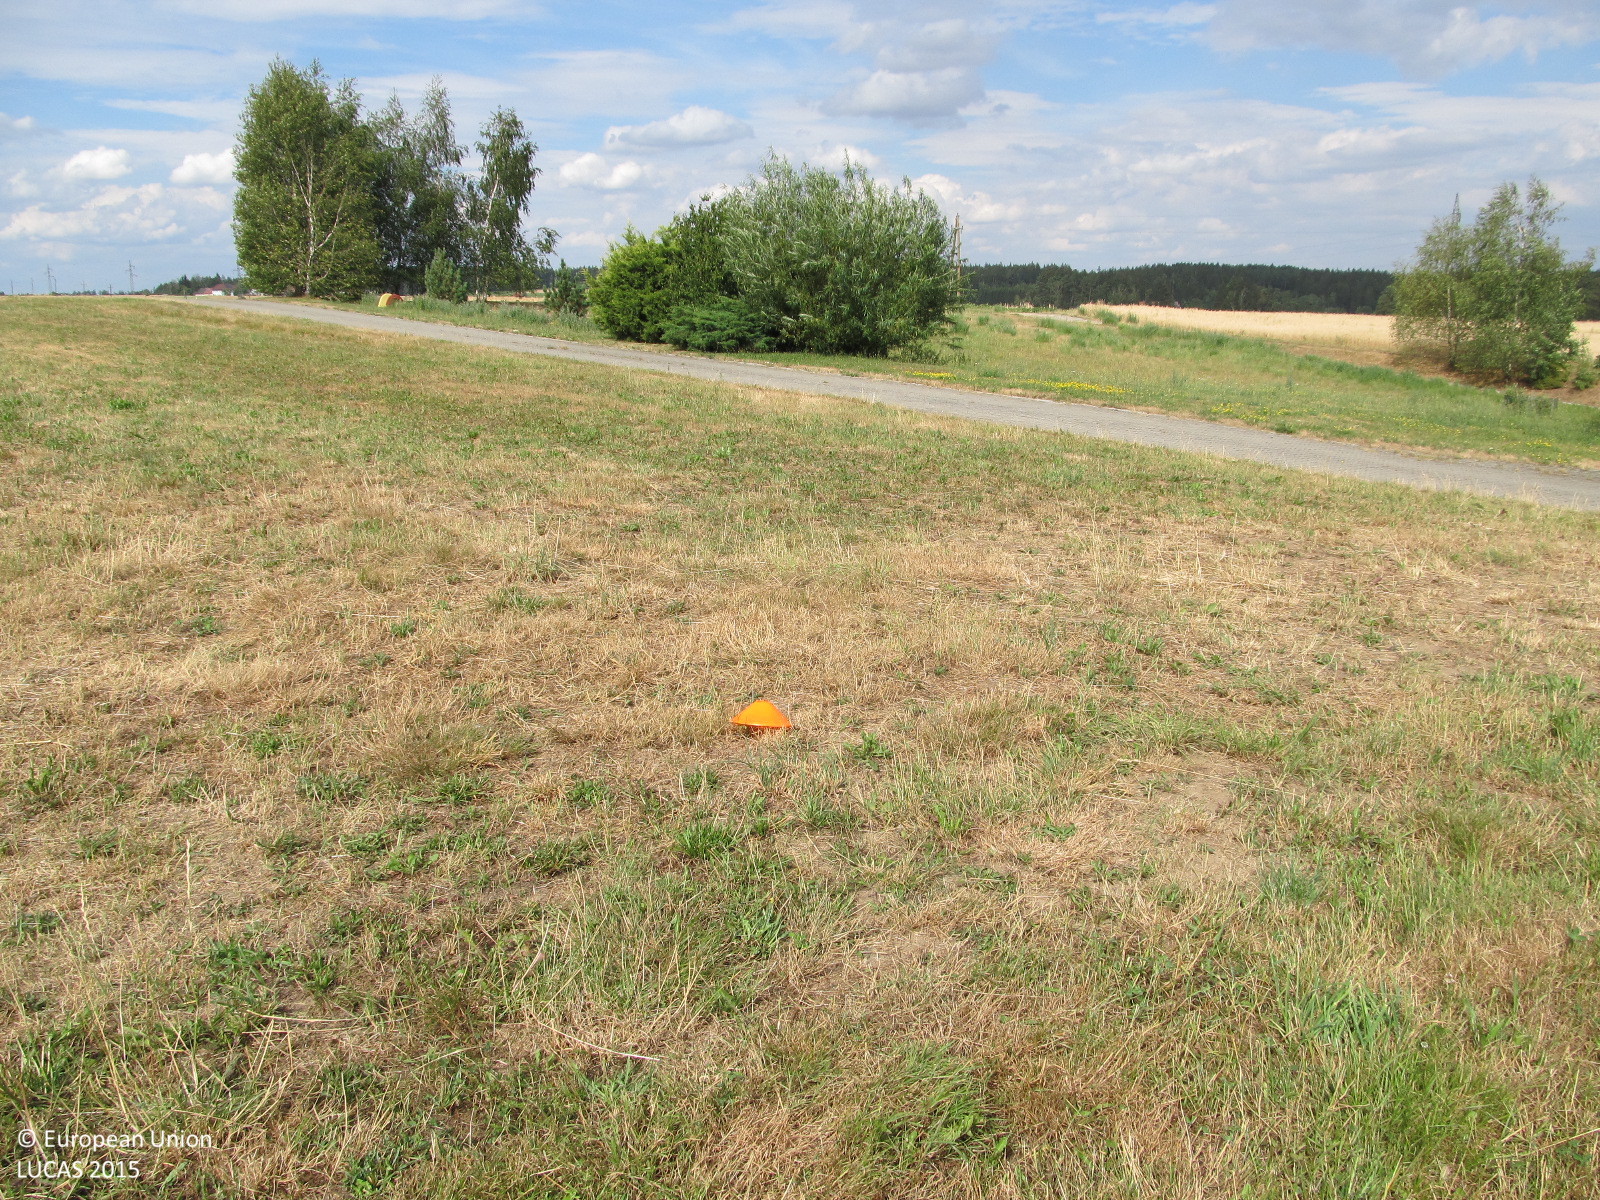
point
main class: Grassland
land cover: Grassland without tree/shrub cover
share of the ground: > 75 %
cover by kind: herbaceous plants 95 %, consolidated bare surface 5 %
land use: Agriculture (excluding fallow land and kitchen gardens)
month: July
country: AT
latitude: 48.6839
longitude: 15.0684
